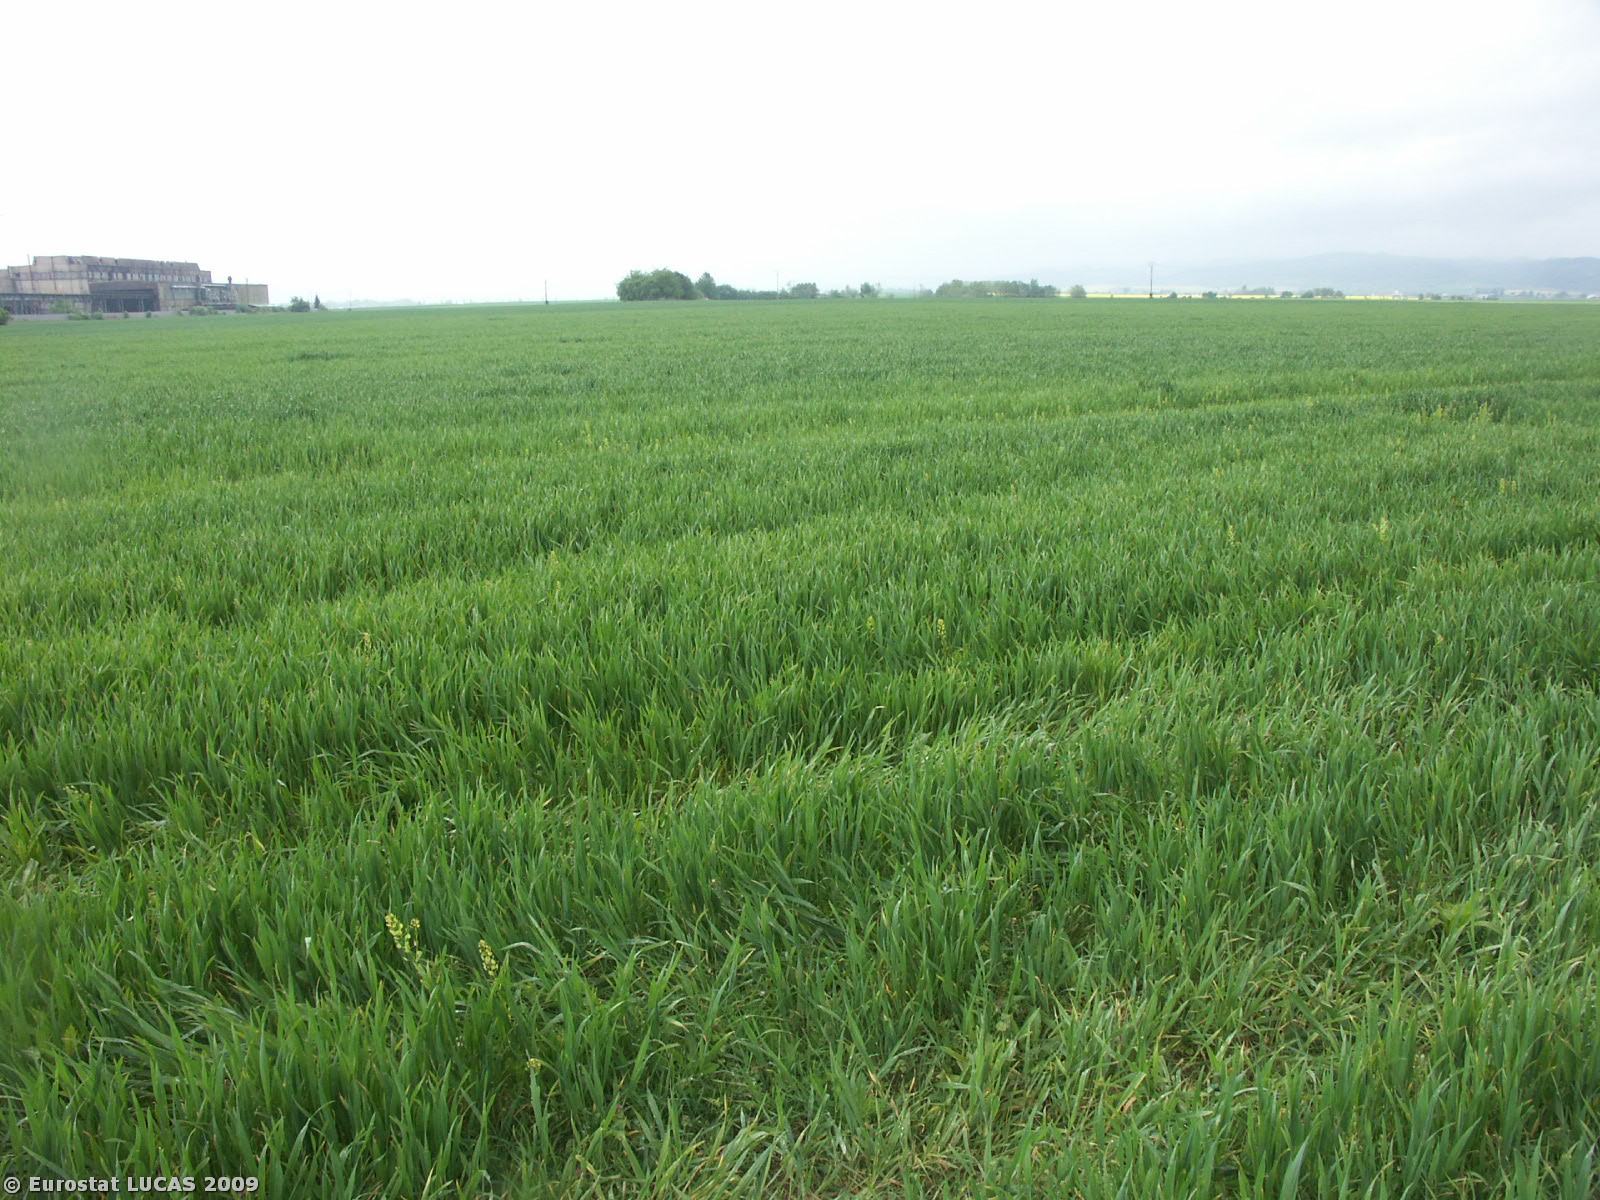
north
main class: Cropland
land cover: Common wheat
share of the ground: > 75 %
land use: Agriculture (excluding fallow land and kitchen gardens)
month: May
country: CZ
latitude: 49.7783
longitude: 17.1623
